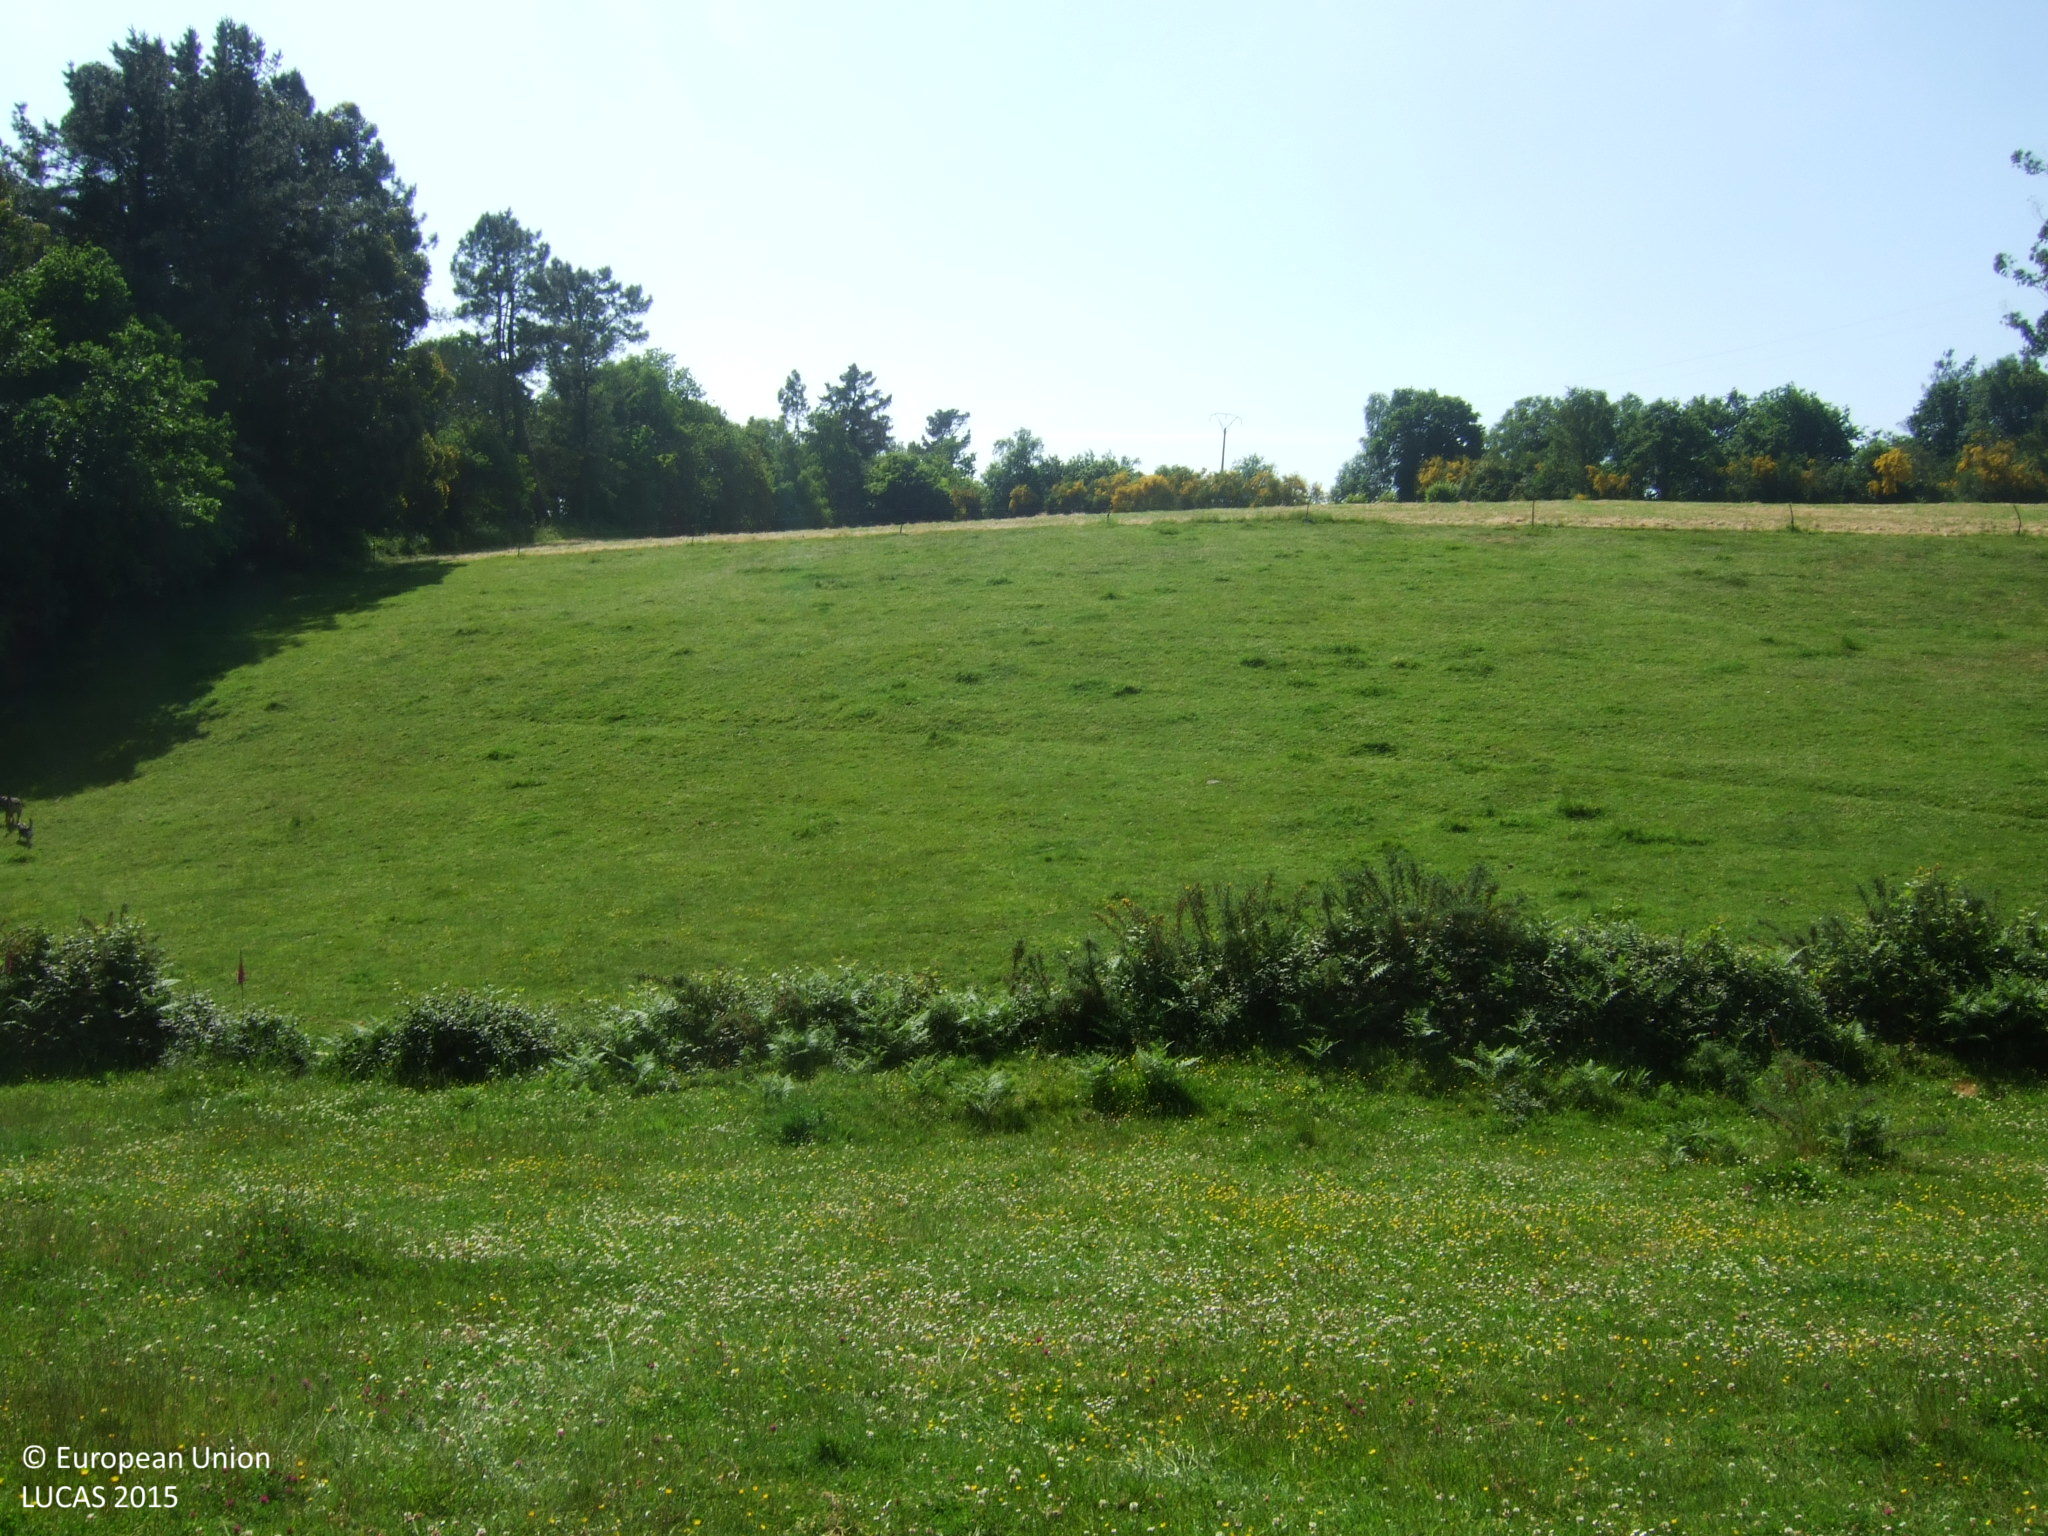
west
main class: Grassland
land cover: Grassland without tree/shrub cover
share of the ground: > 75 %
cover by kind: herbaceous plants 100 %
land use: Agriculture (excluding fallow land and kitchen gardens)
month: June
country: ES
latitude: 43.2873
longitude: -7.4170
